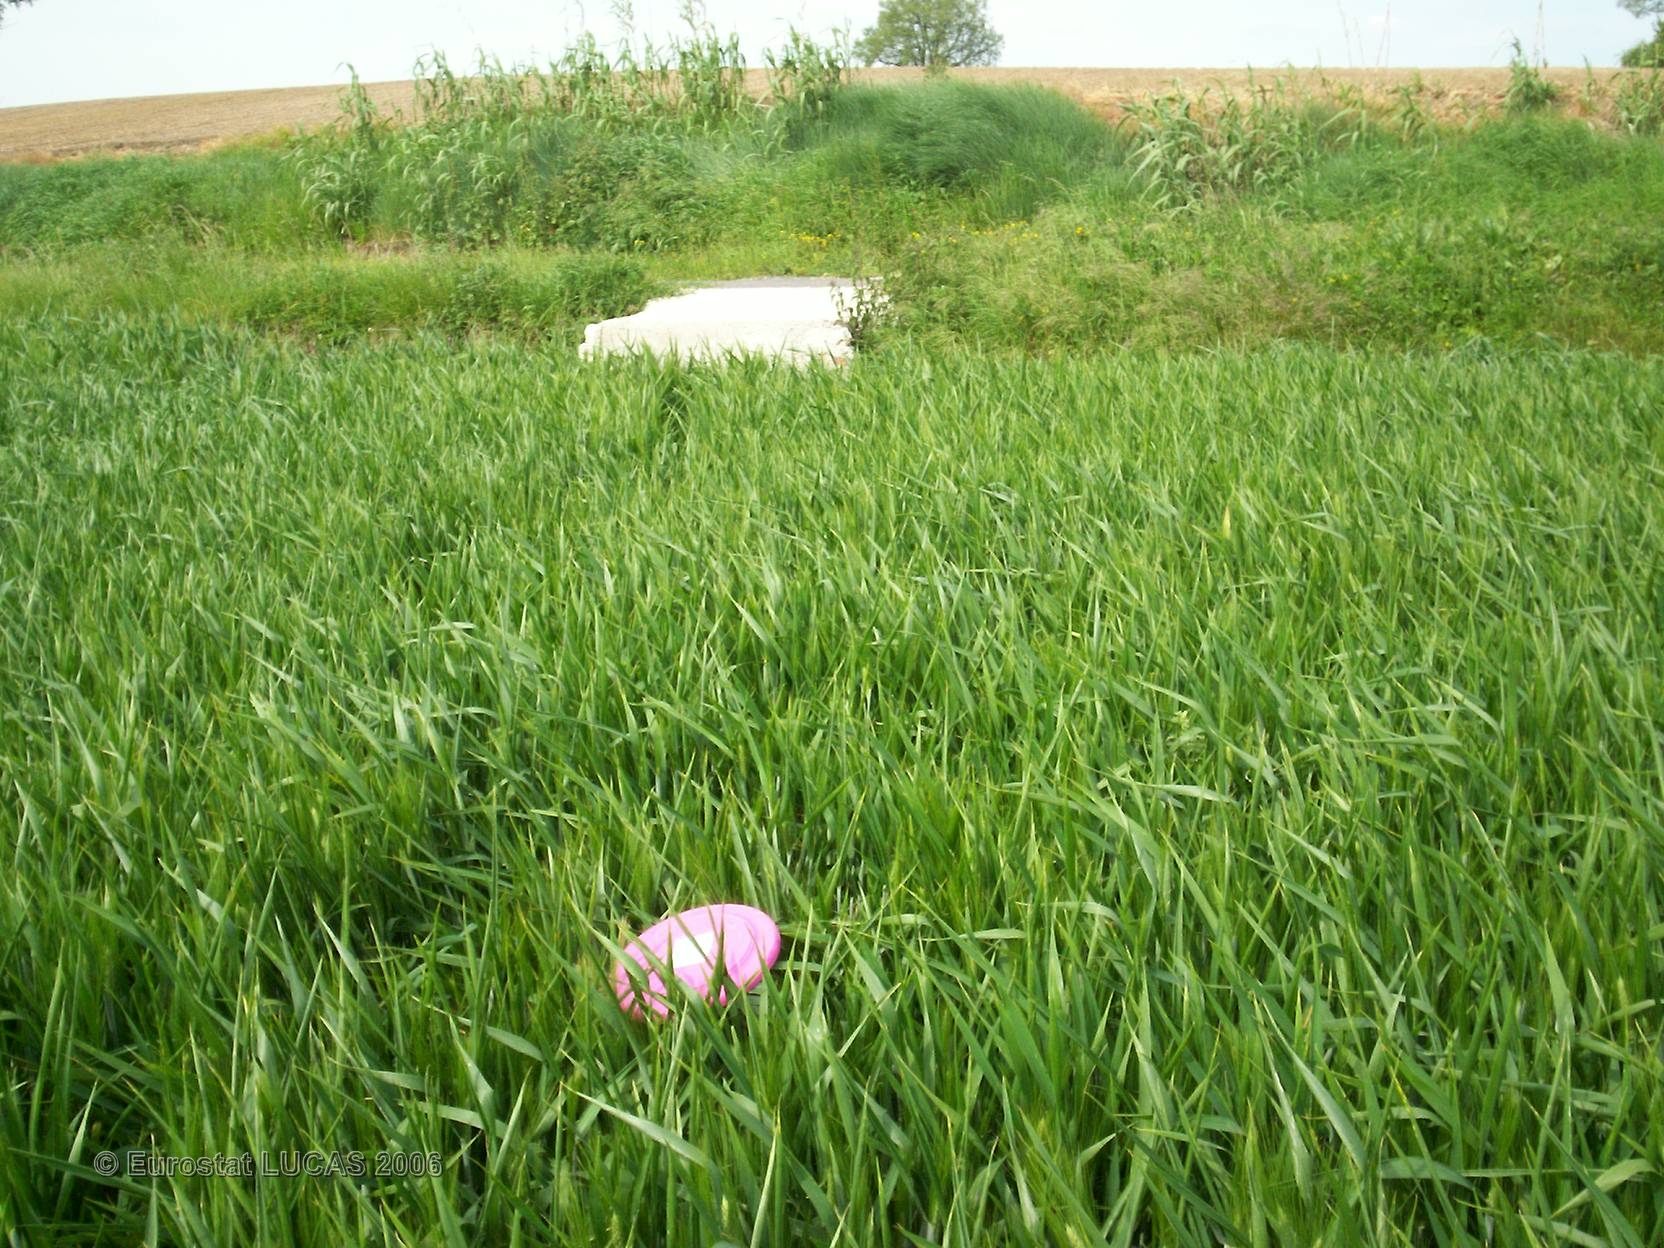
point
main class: Cropland
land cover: Durum wheat
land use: Agriculture (excluding fallow land and kitchen gardens)
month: May
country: FR
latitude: 43.8425
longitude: 2.0061
